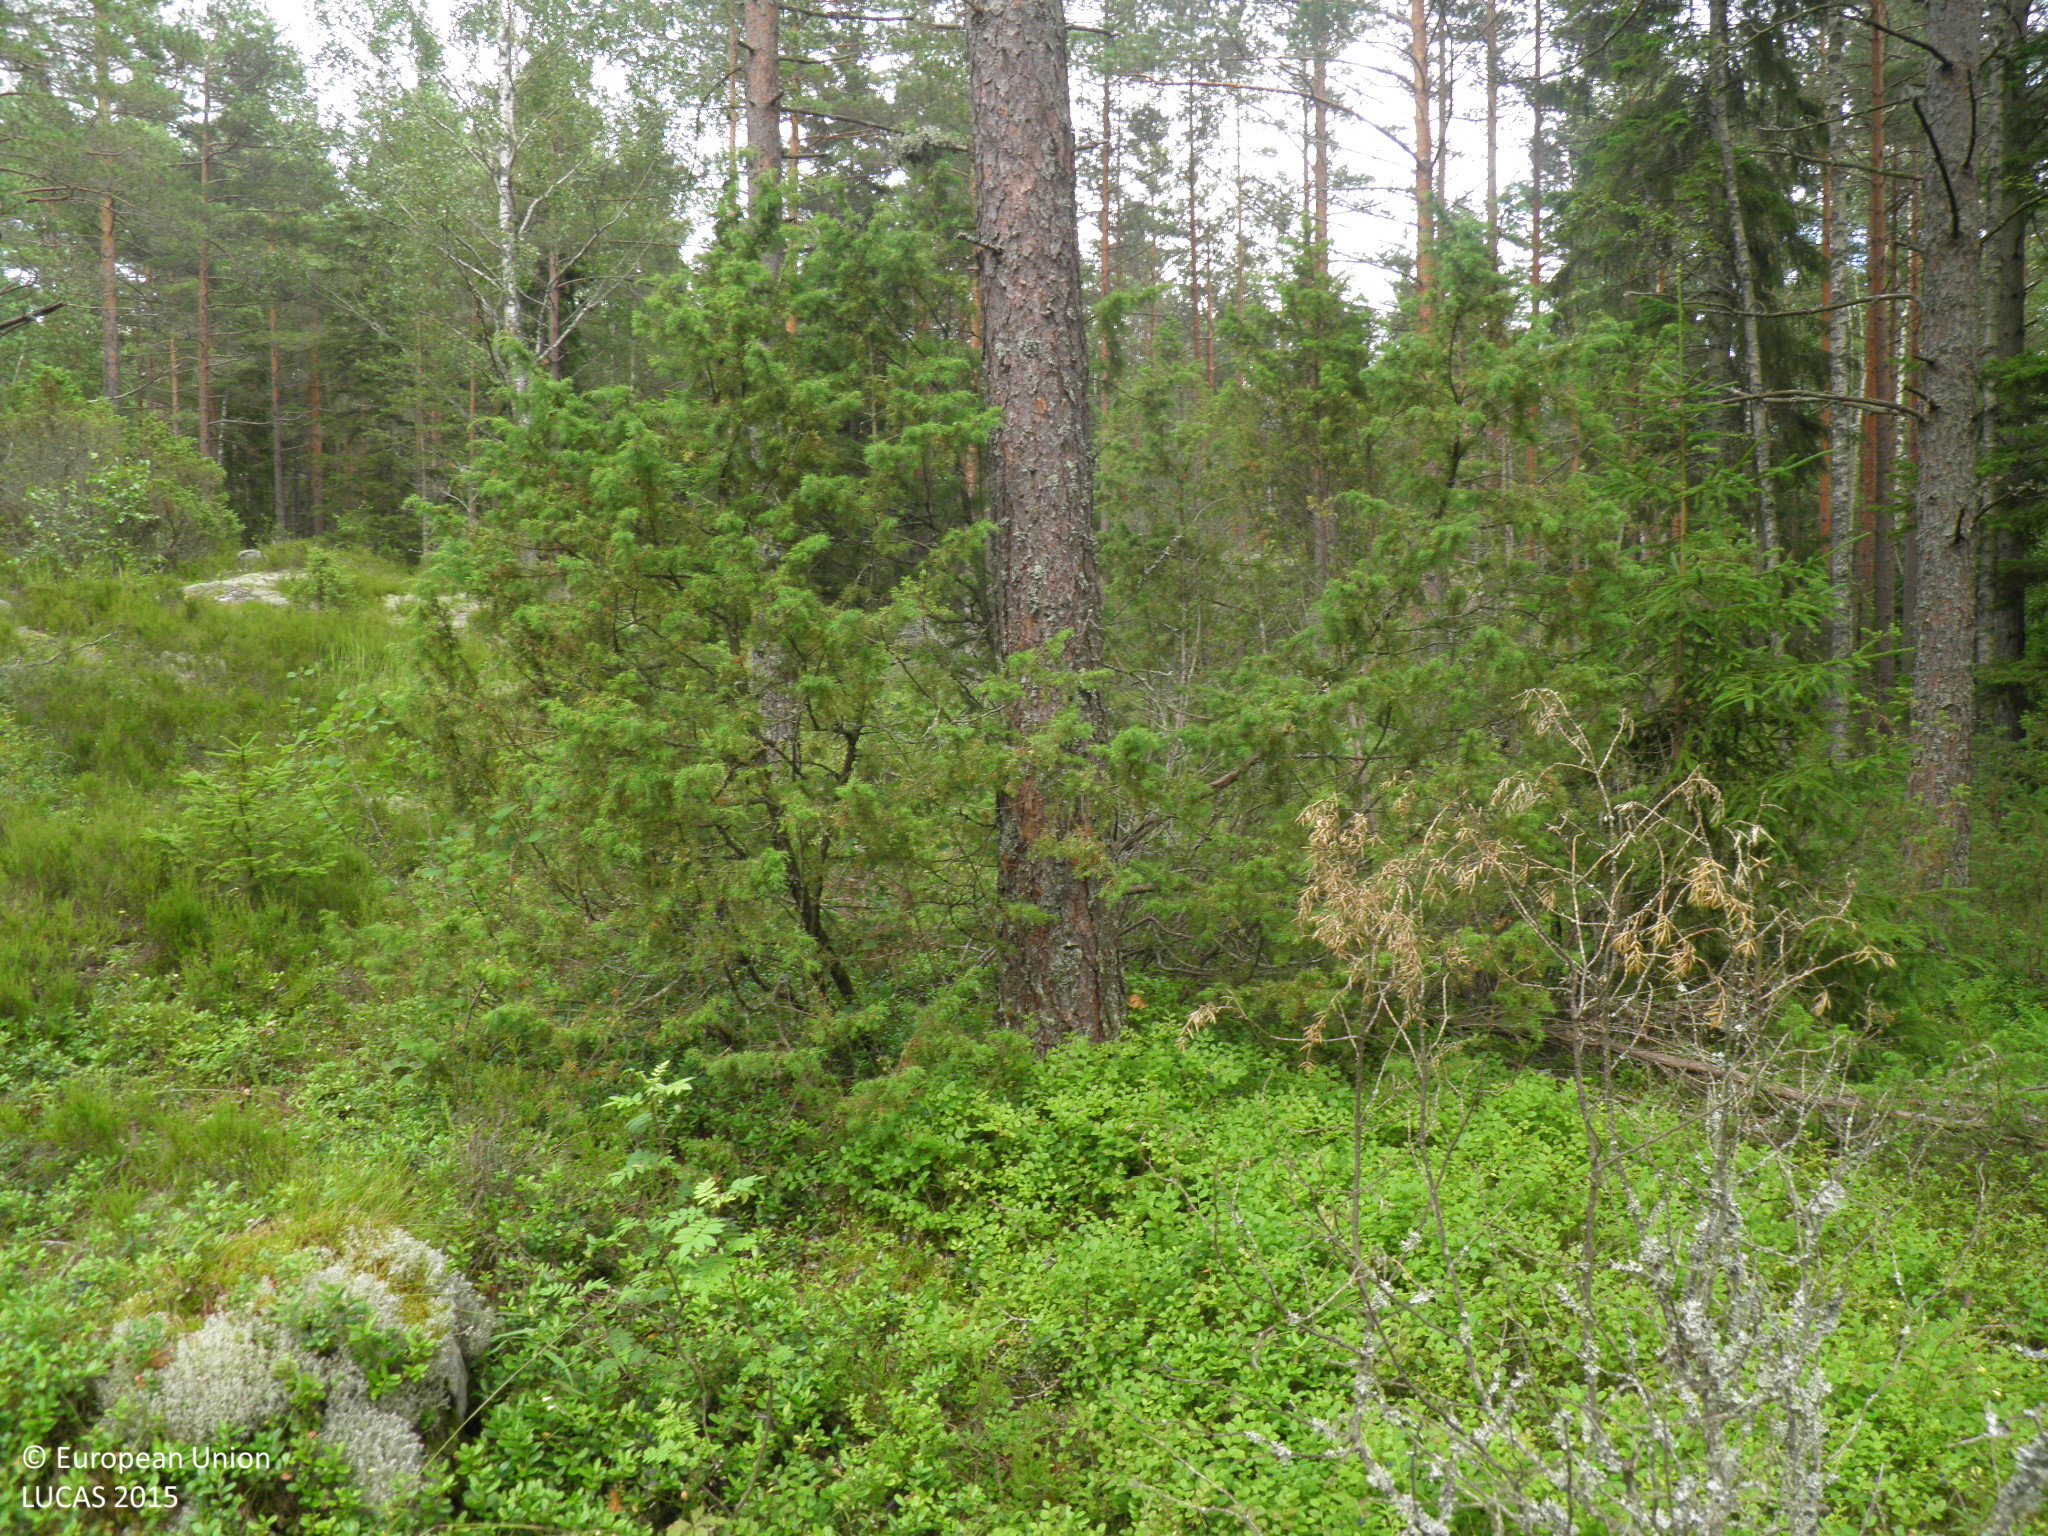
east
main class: Woodland
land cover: Pine dominated coniferous woodland
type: hemiboreal forest and nemoral coniferous forest and mixed broadleaved-coniferous forest
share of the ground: 25 - 50 %
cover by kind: shrubs 50 %, coniferous forest trees 25 %, herbaceous plants 20 %, broadleaved forest trees 5 %
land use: Forestry
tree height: > 5 m
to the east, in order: Pine dominated coniferous woodland; Ditches and canals; Pine dominated coniferous woodland
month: July
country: FI
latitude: 60.0487
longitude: 22.6266
